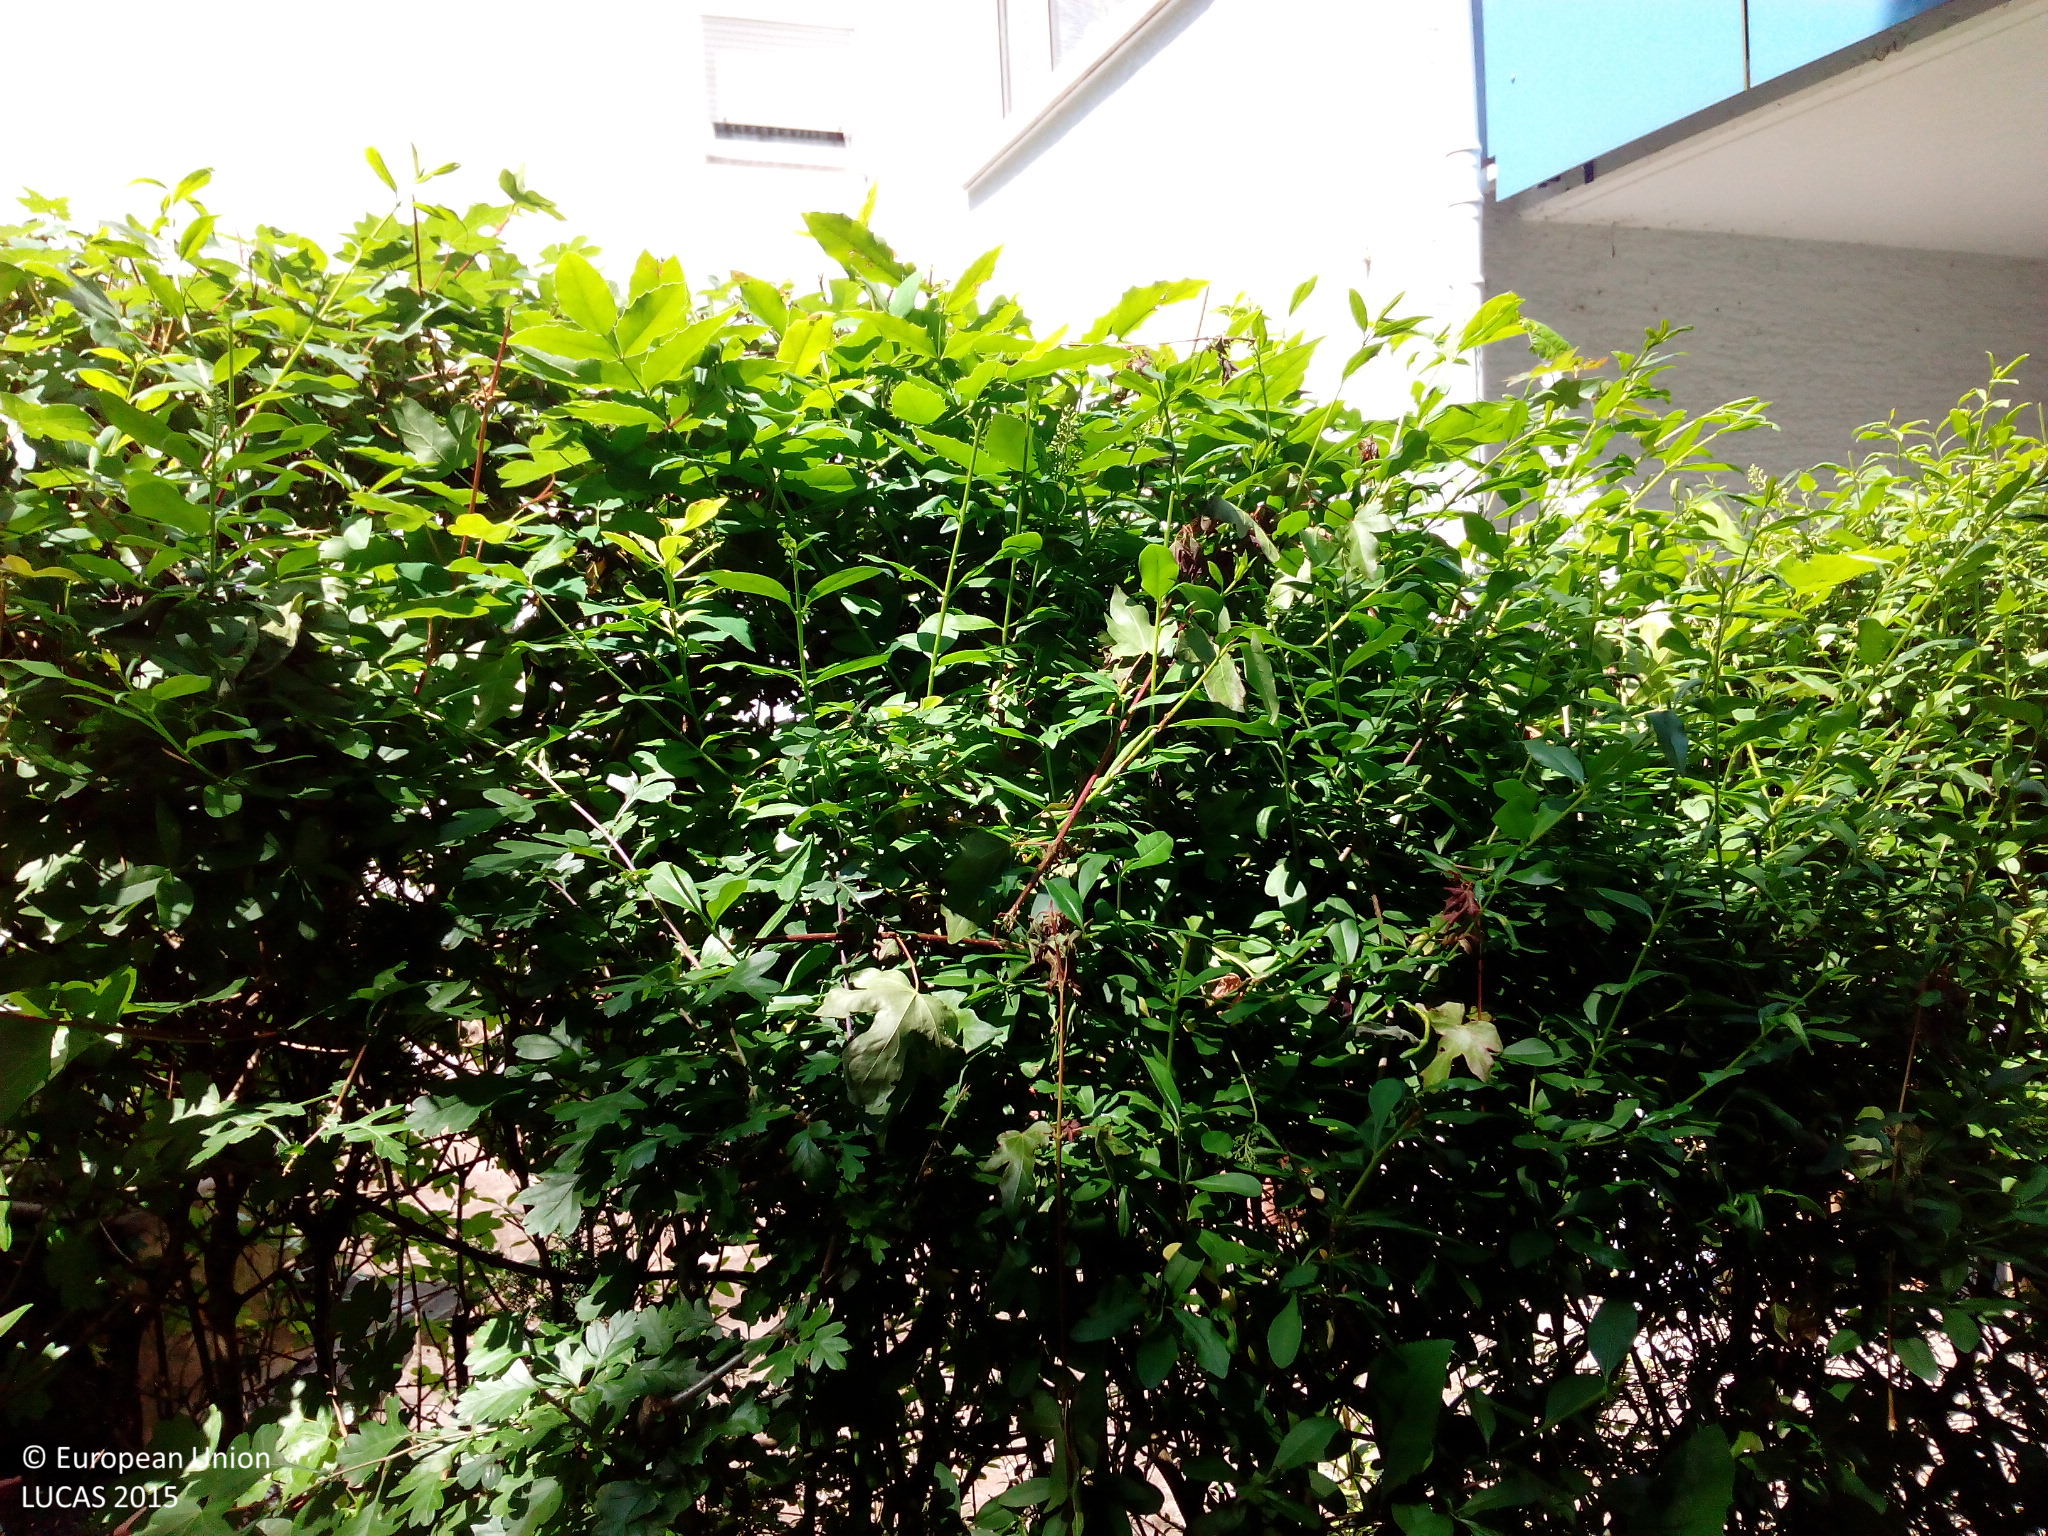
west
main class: Grassland
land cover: Grassland without tree/shrub cover
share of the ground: > 75 %
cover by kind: herbaceous plants 100 %
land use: Residential
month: June
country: DE
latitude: 48.9409
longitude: 9.2767
